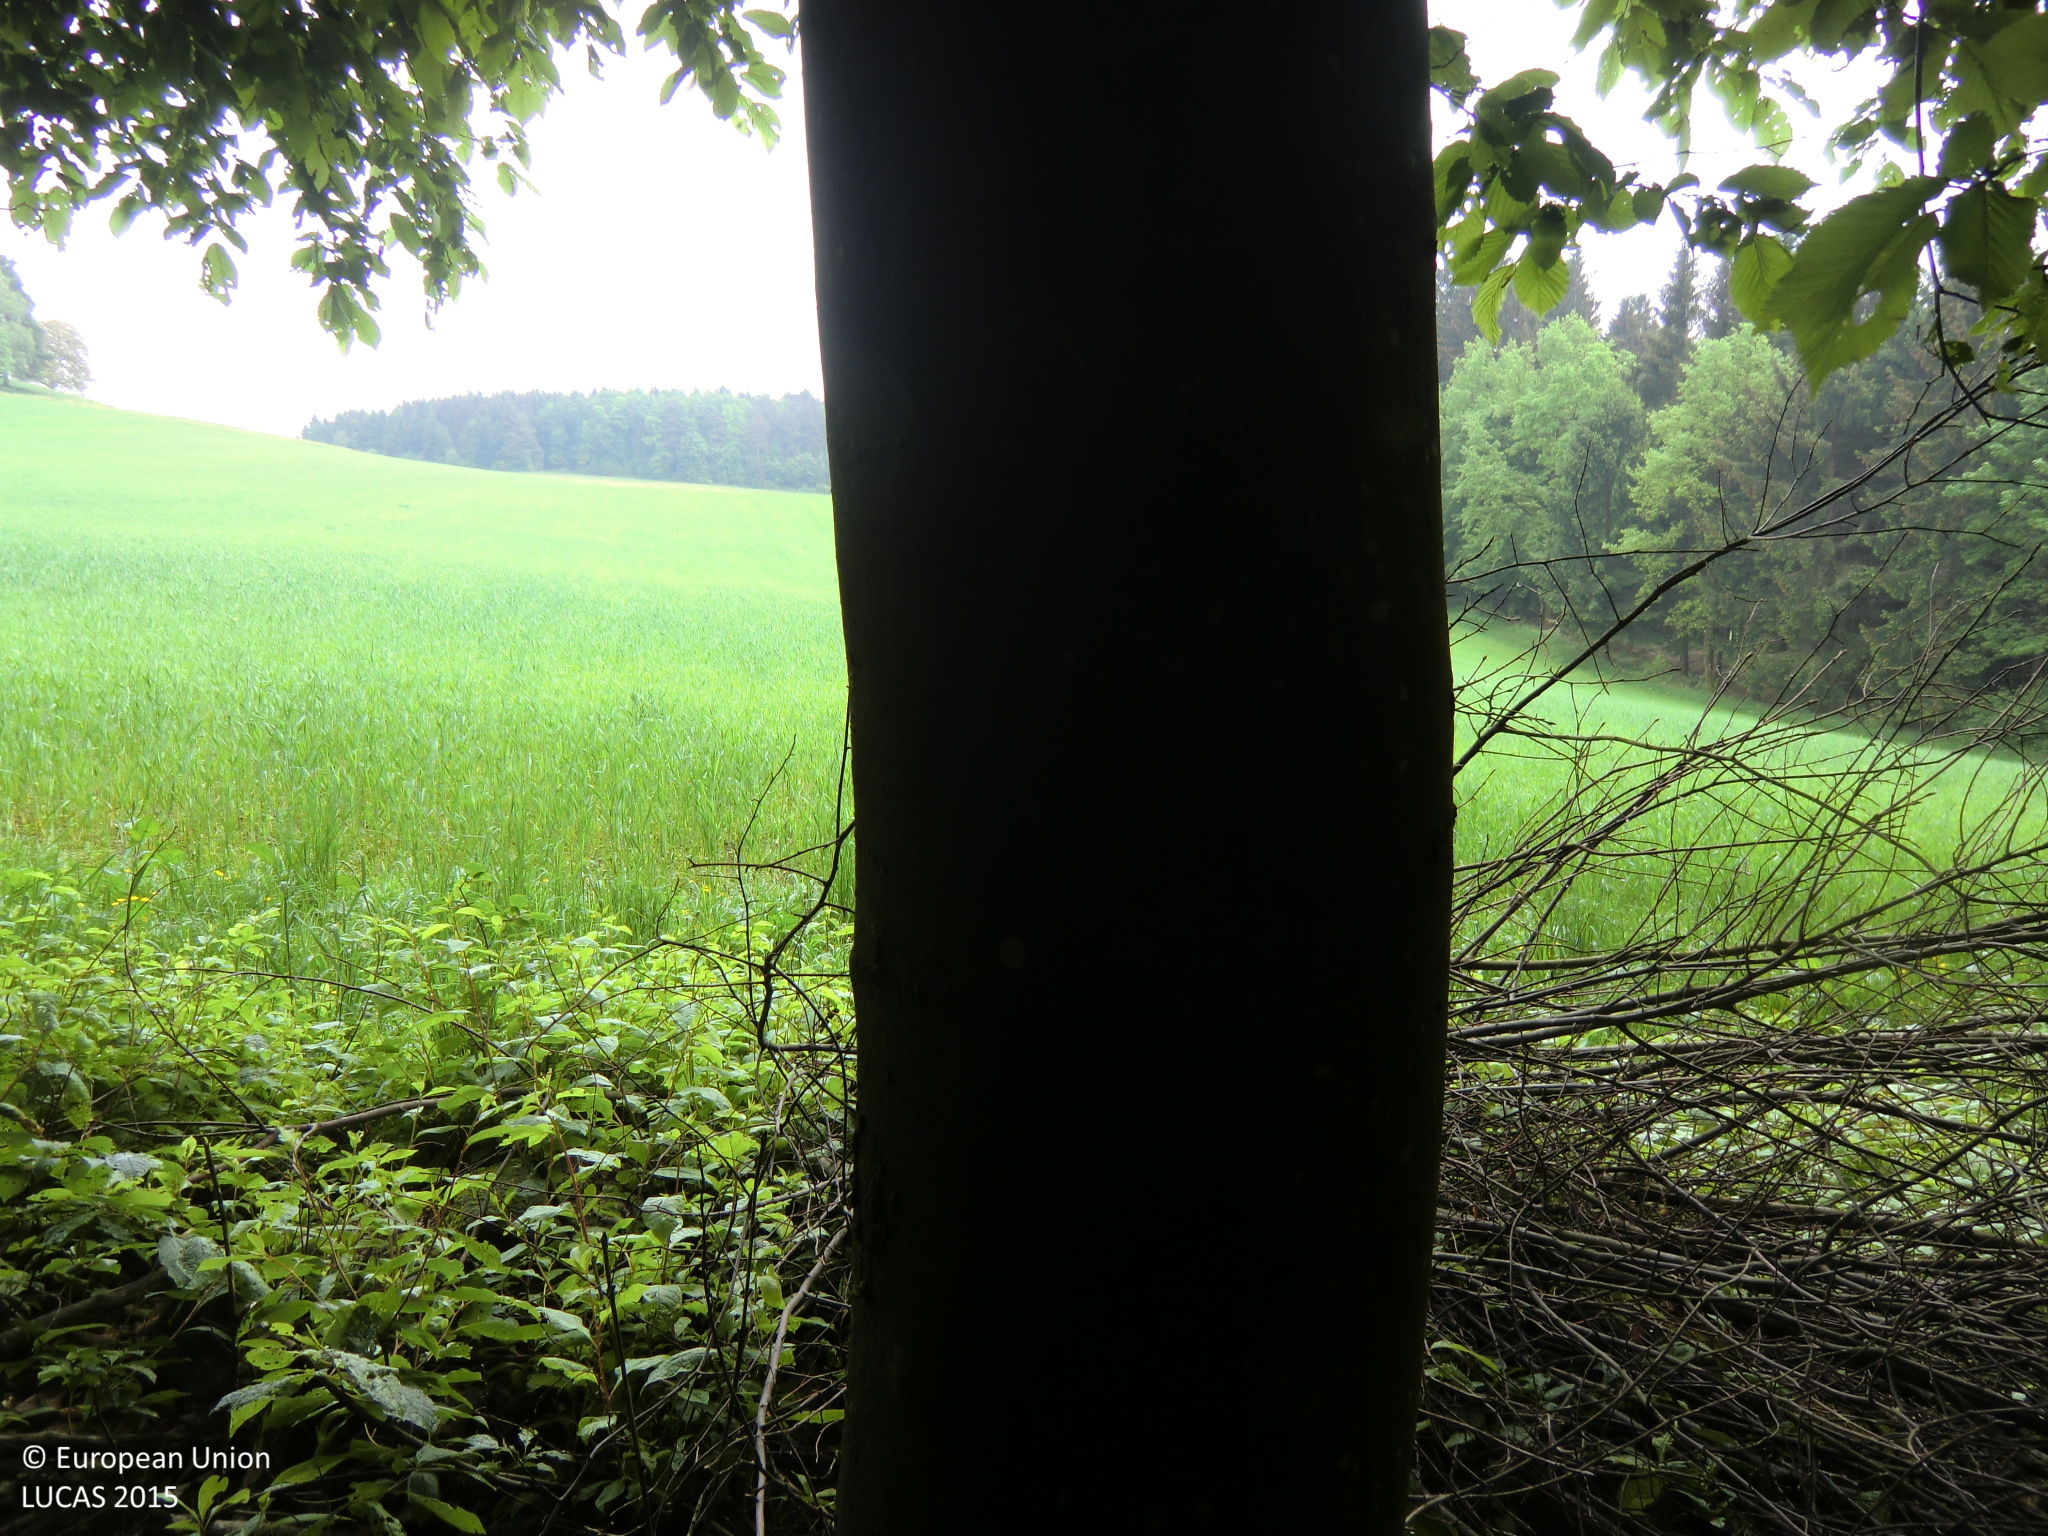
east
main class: Woodland
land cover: Broadleaved woodland
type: hemiboreal forest and nemoral coniferous forest and mixed broadleaved-coniferous forest
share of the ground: > 75 %
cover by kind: broadleaved forest trees 75 %, herbaceous plants 20 %, unconsolidated bare surface 5 %
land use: Forestry
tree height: > 5 m
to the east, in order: Broadleaved woodland; Tracks; Common wheat; Grassland without tree/shrub cover
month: May
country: AT
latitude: 48.3557
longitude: 14.3053
